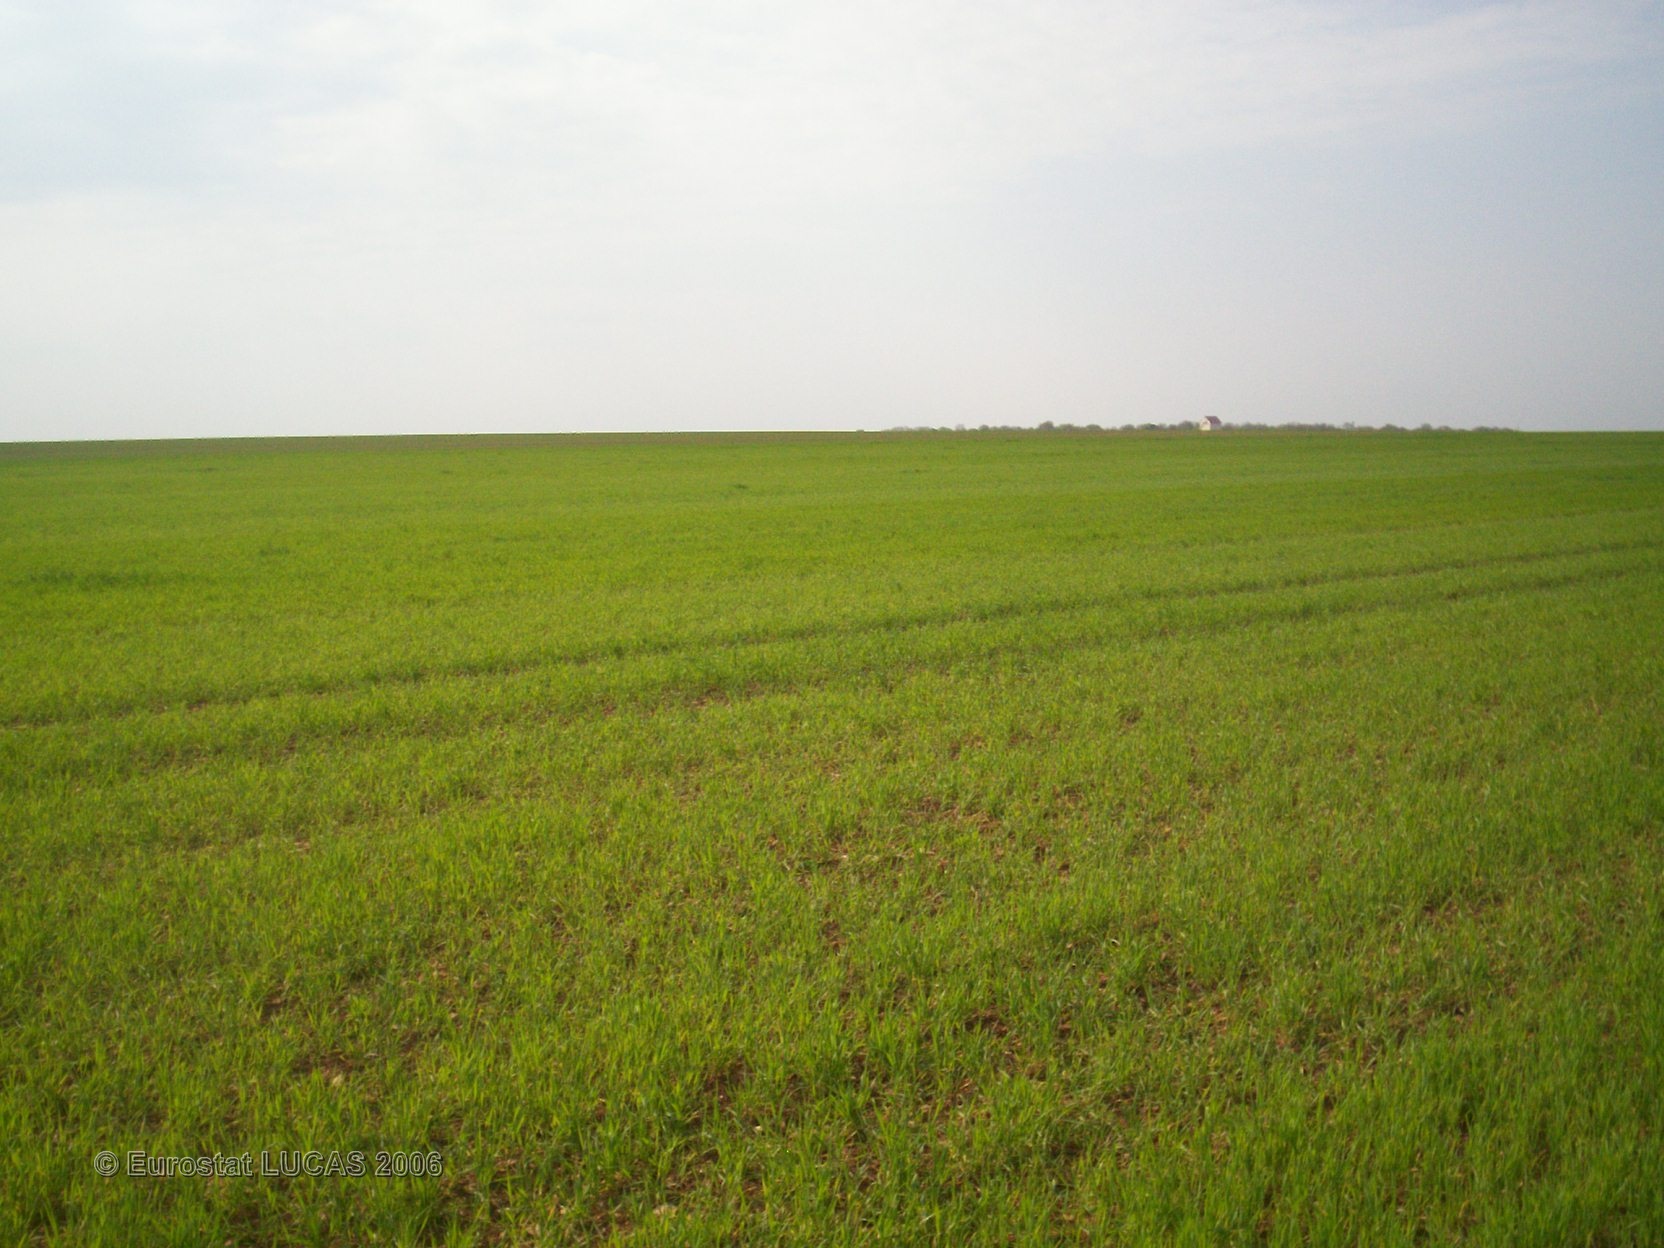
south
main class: Cropland
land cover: Common wheat
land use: Agriculture (excluding fallow land and kitchen gardens)
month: May
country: FR
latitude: 47.5523
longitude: 4.6441
